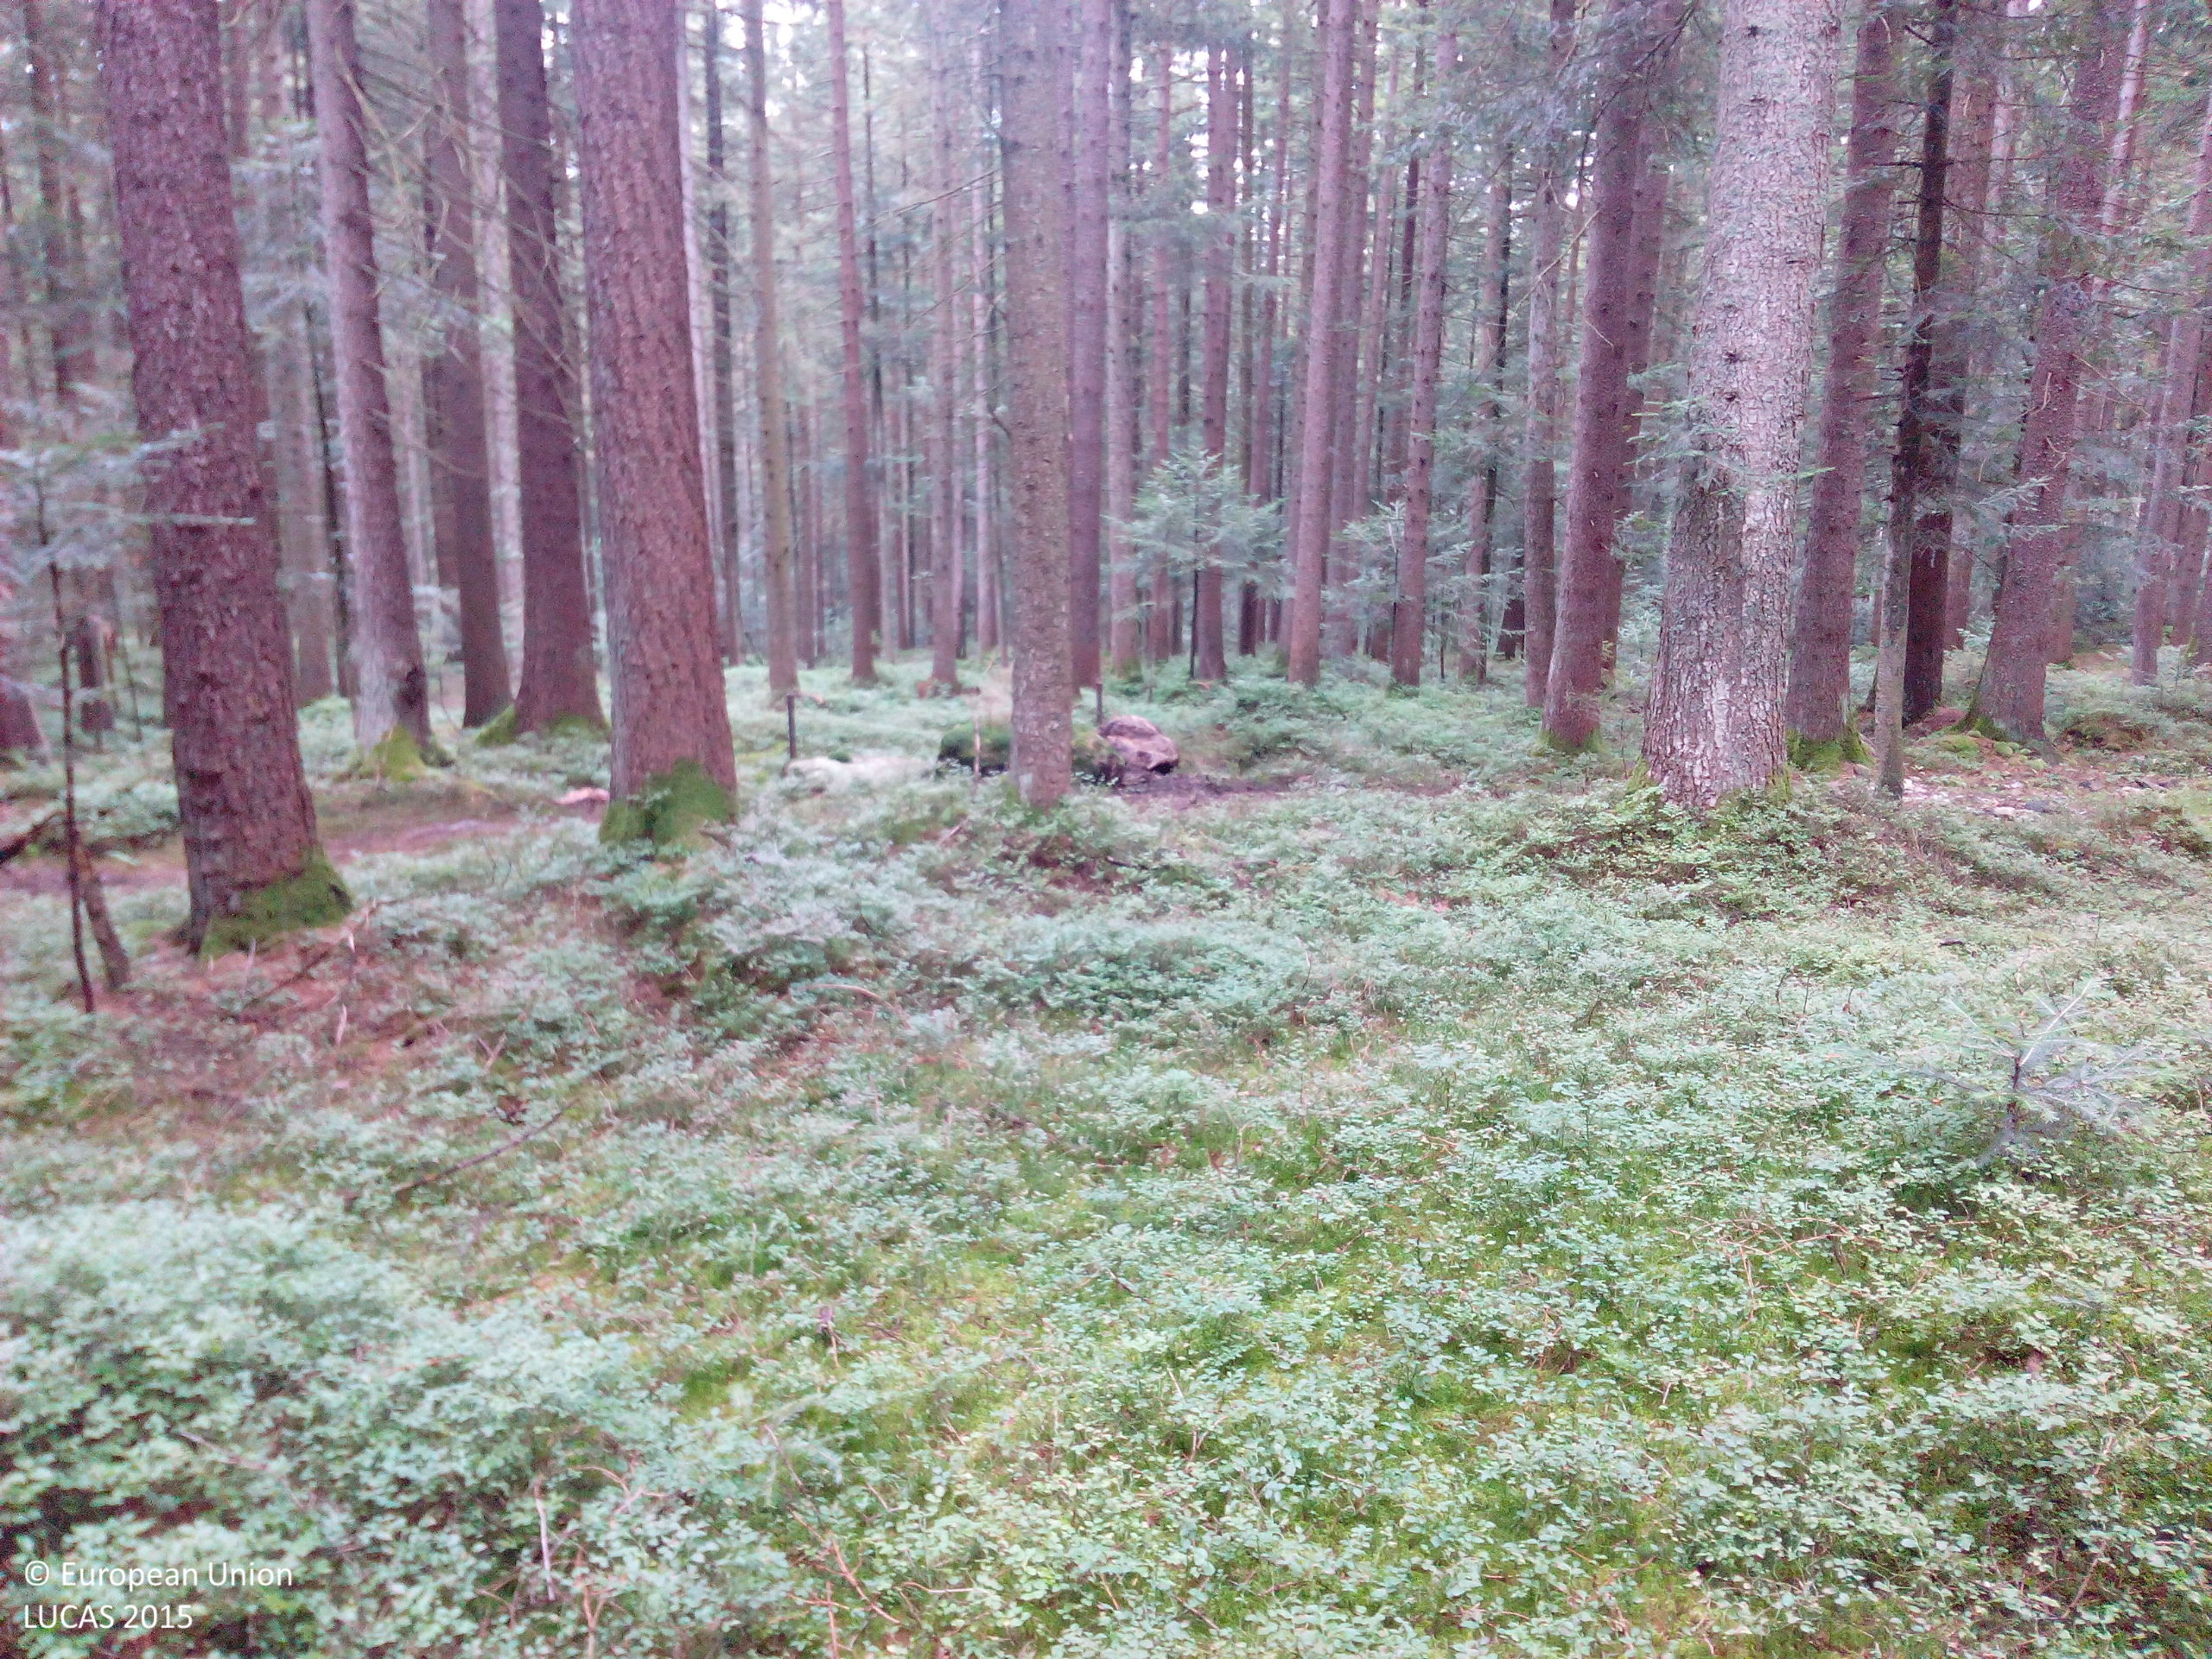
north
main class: Woodland
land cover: Spruce dominated coniferous woodland
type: hemiboreal forest and nemoral coniferous forest and mixed broadleaved-coniferous forest
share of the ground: > 75 %
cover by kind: coniferous forest trees 75 %, shrubs 15 %, unconsolidated bare surface 10 %
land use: Forestry
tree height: > 5 m
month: September
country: DE
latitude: 48.9586
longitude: 12.9359
